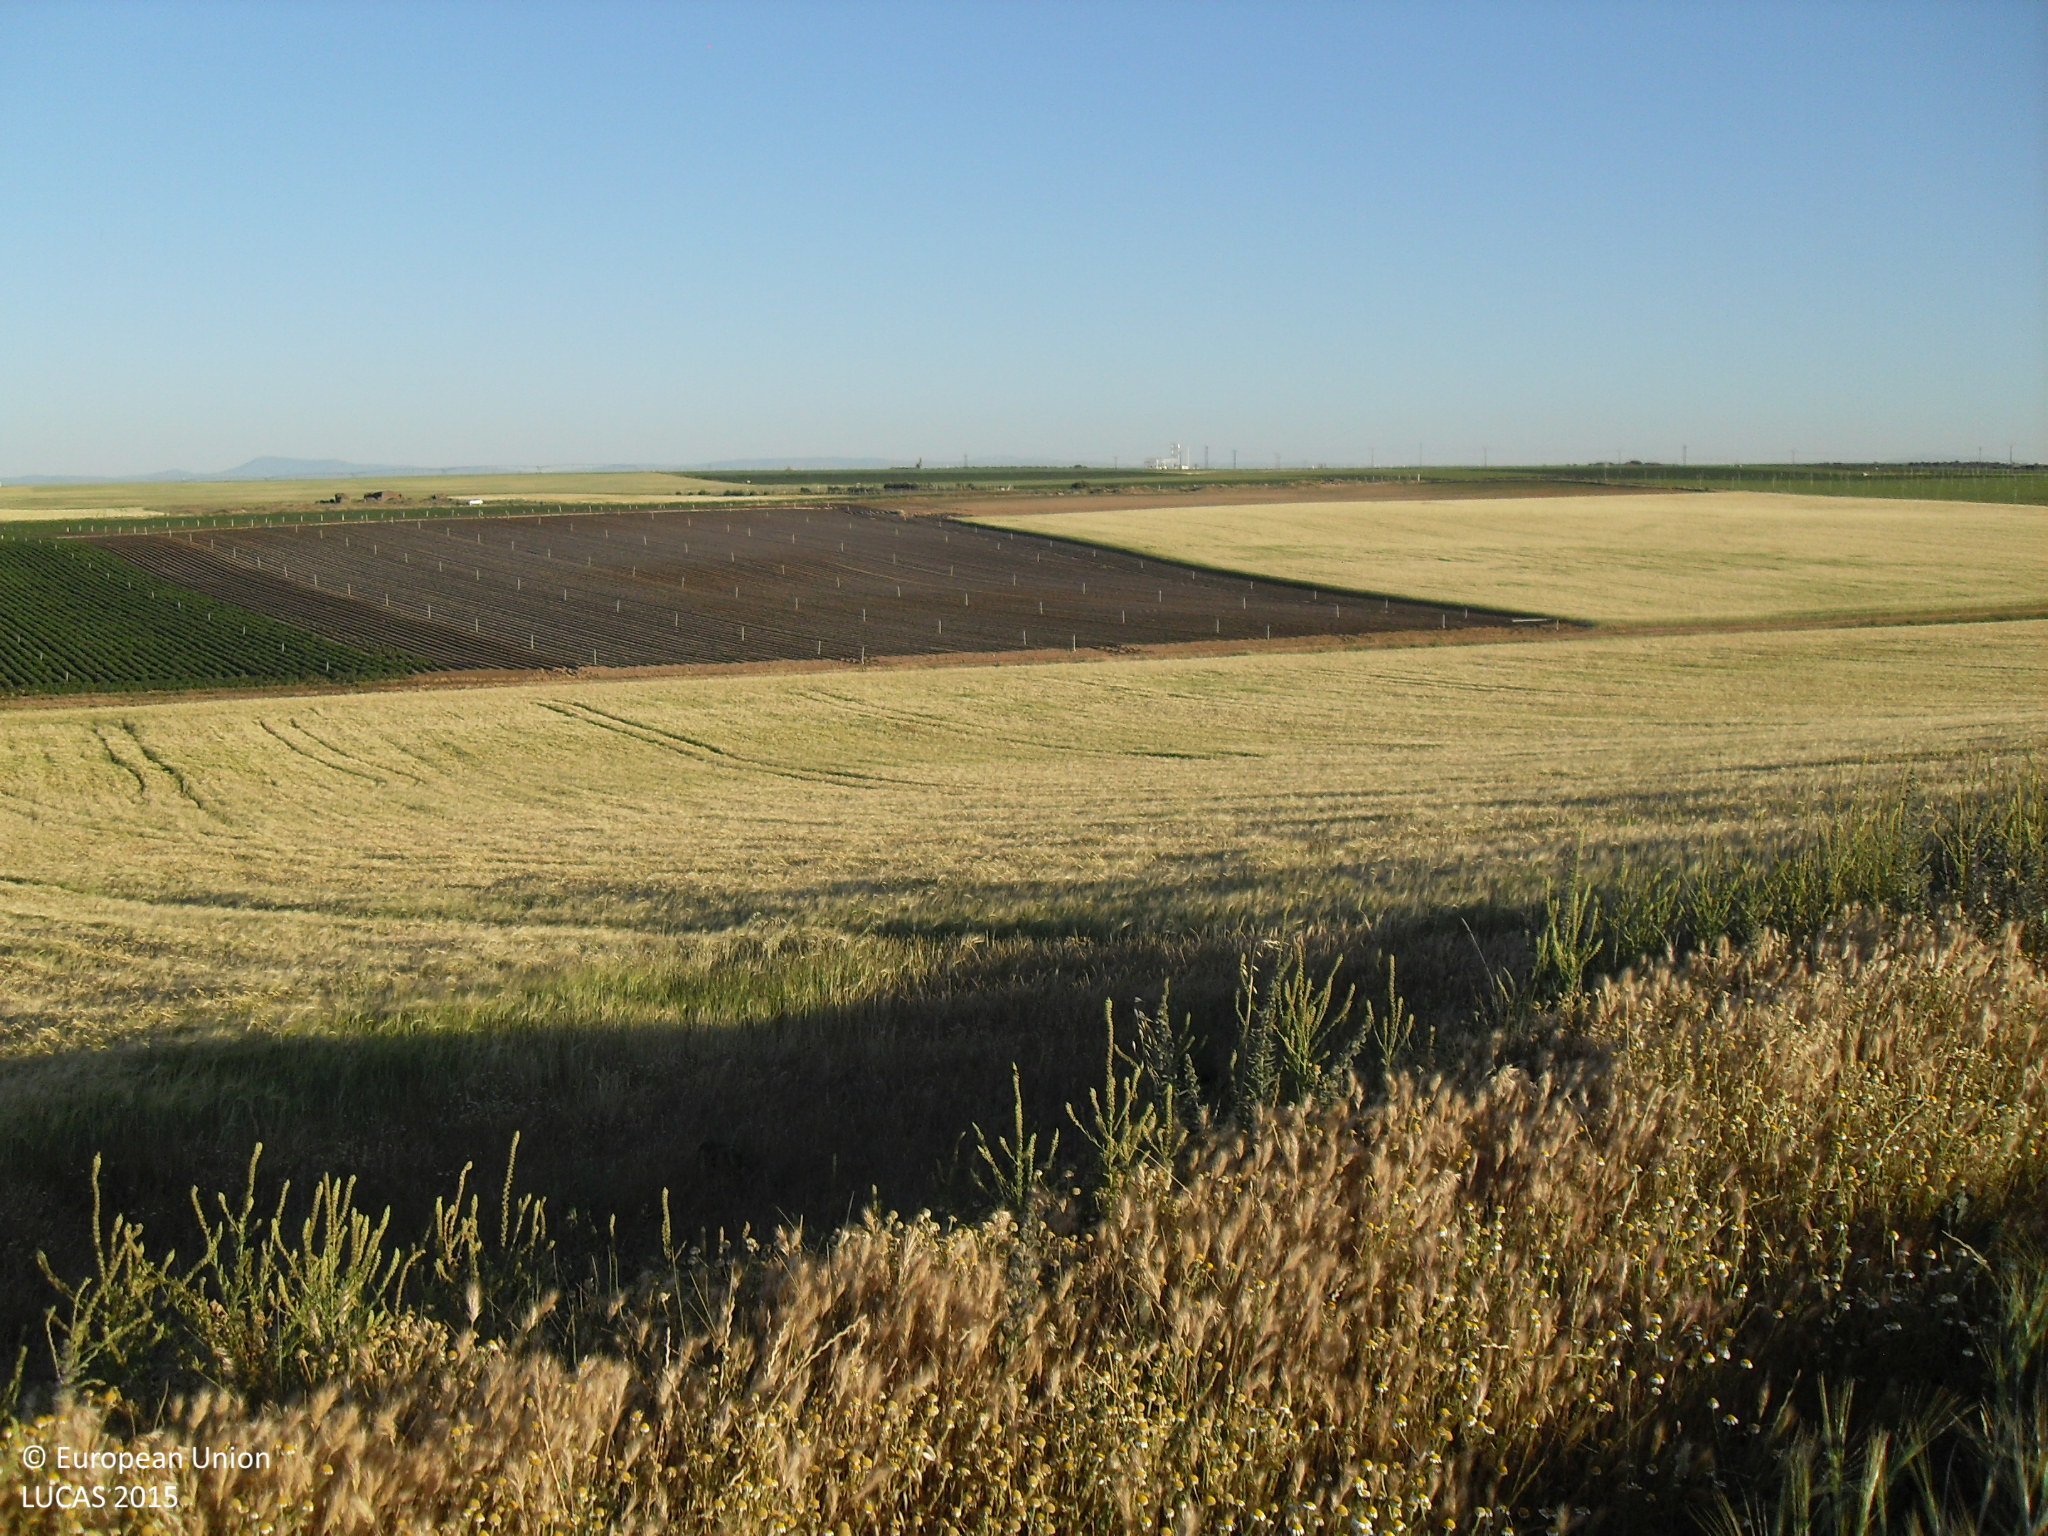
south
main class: Cropland
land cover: Barley
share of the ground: > 75 %
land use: Agriculture (excluding fallow land and kitchen gardens)
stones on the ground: 25 - 50 %
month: May
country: ES
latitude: 41.0659
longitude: -5.3891
